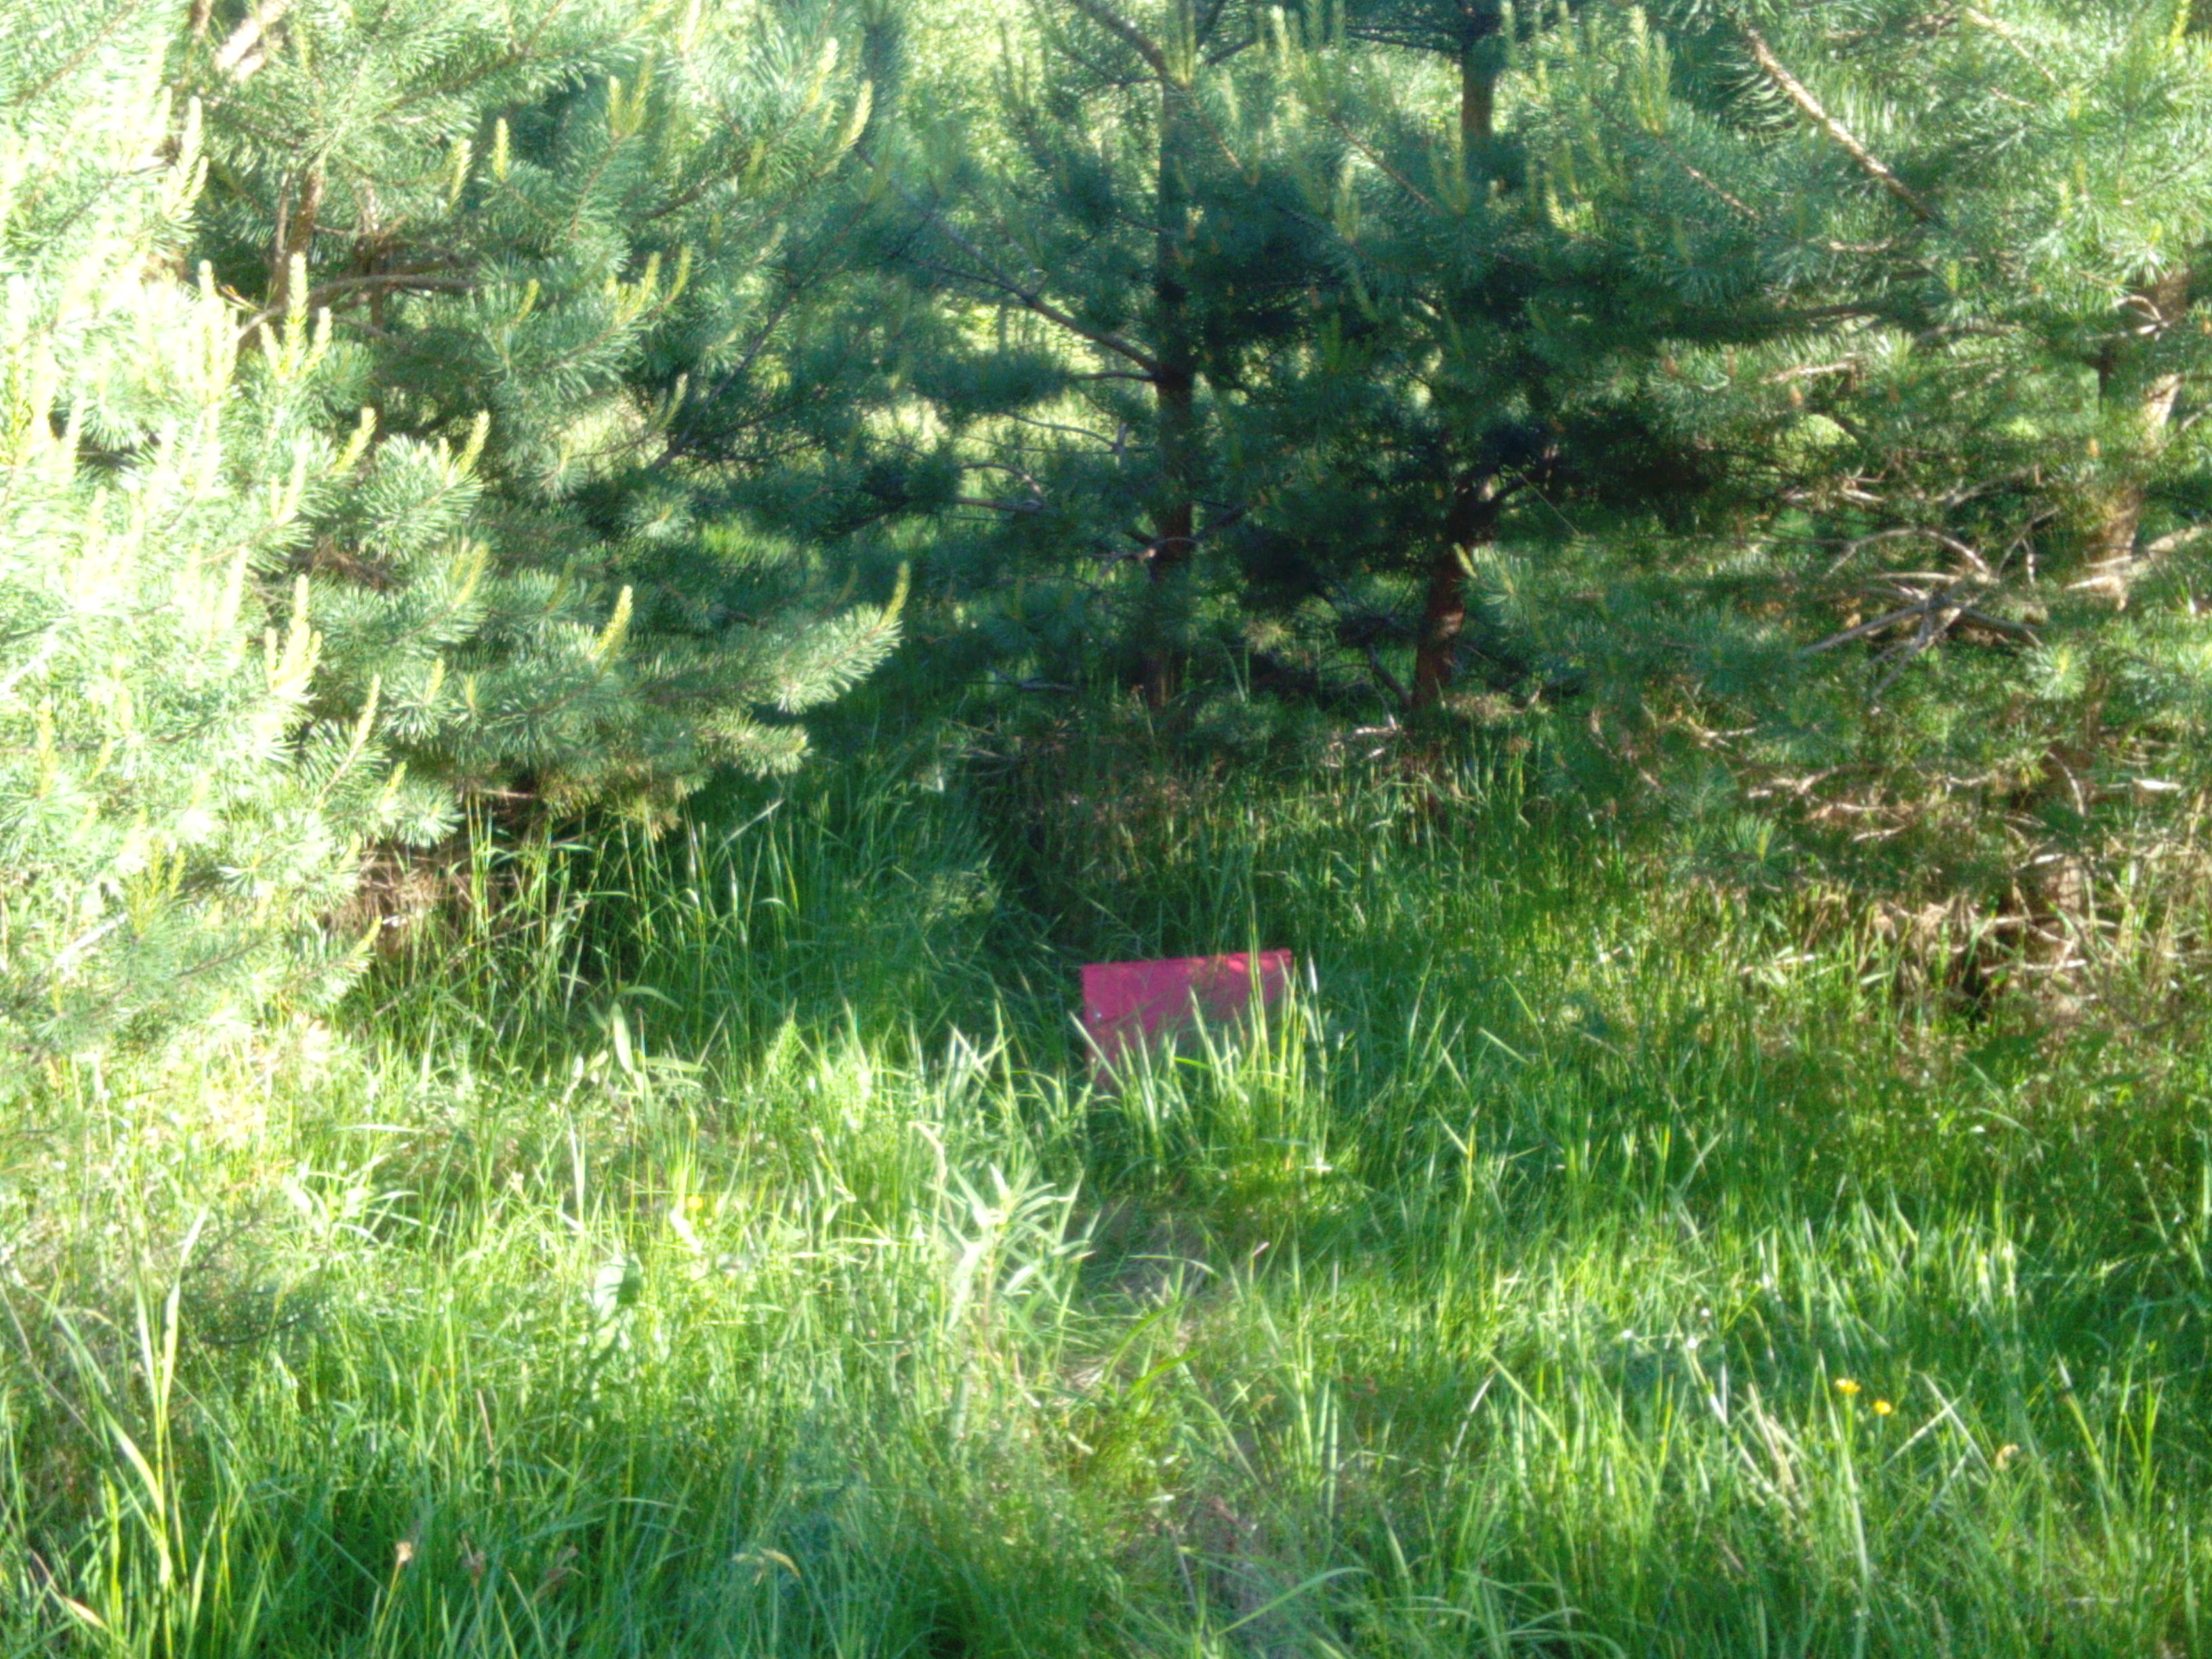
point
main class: Woodland
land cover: Pine dominated coniferous woodland
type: hemiboreal forest and nemoral coniferous forest and mixed broadleaved-coniferous forest
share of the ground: 50 - 75 %
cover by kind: coniferous forest trees 50 %, herbaceous plants 50 %
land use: Forestry
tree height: < 5 m
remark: Nursery
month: June
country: LV
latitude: 56.7208
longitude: 22.1260
